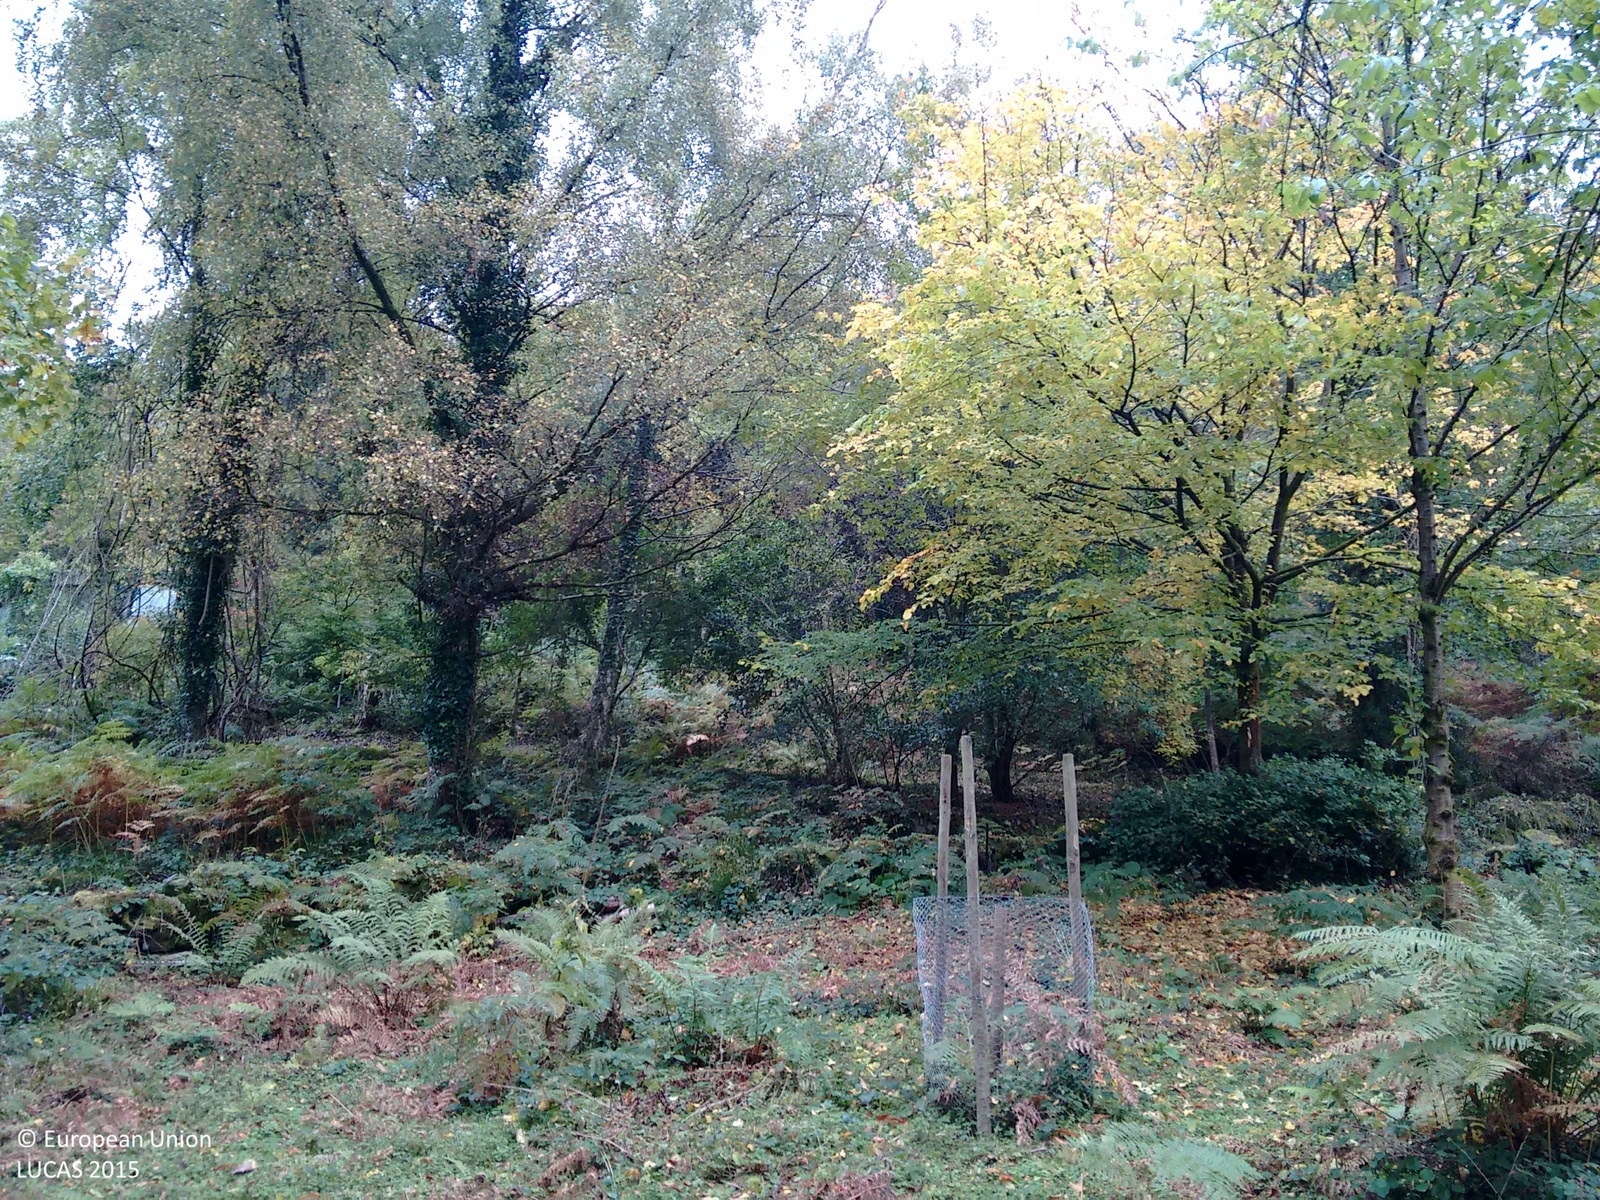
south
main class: Woodland
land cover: Broadleaved woodland
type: mesophytic deciduous forest
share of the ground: > 75 %
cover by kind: broadleaved forest trees 60 %, shrubs 20 %, herbaceous plants 20 %
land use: Residential
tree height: > 5 m
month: October
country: GB
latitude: 51.7335
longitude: -2.6520
